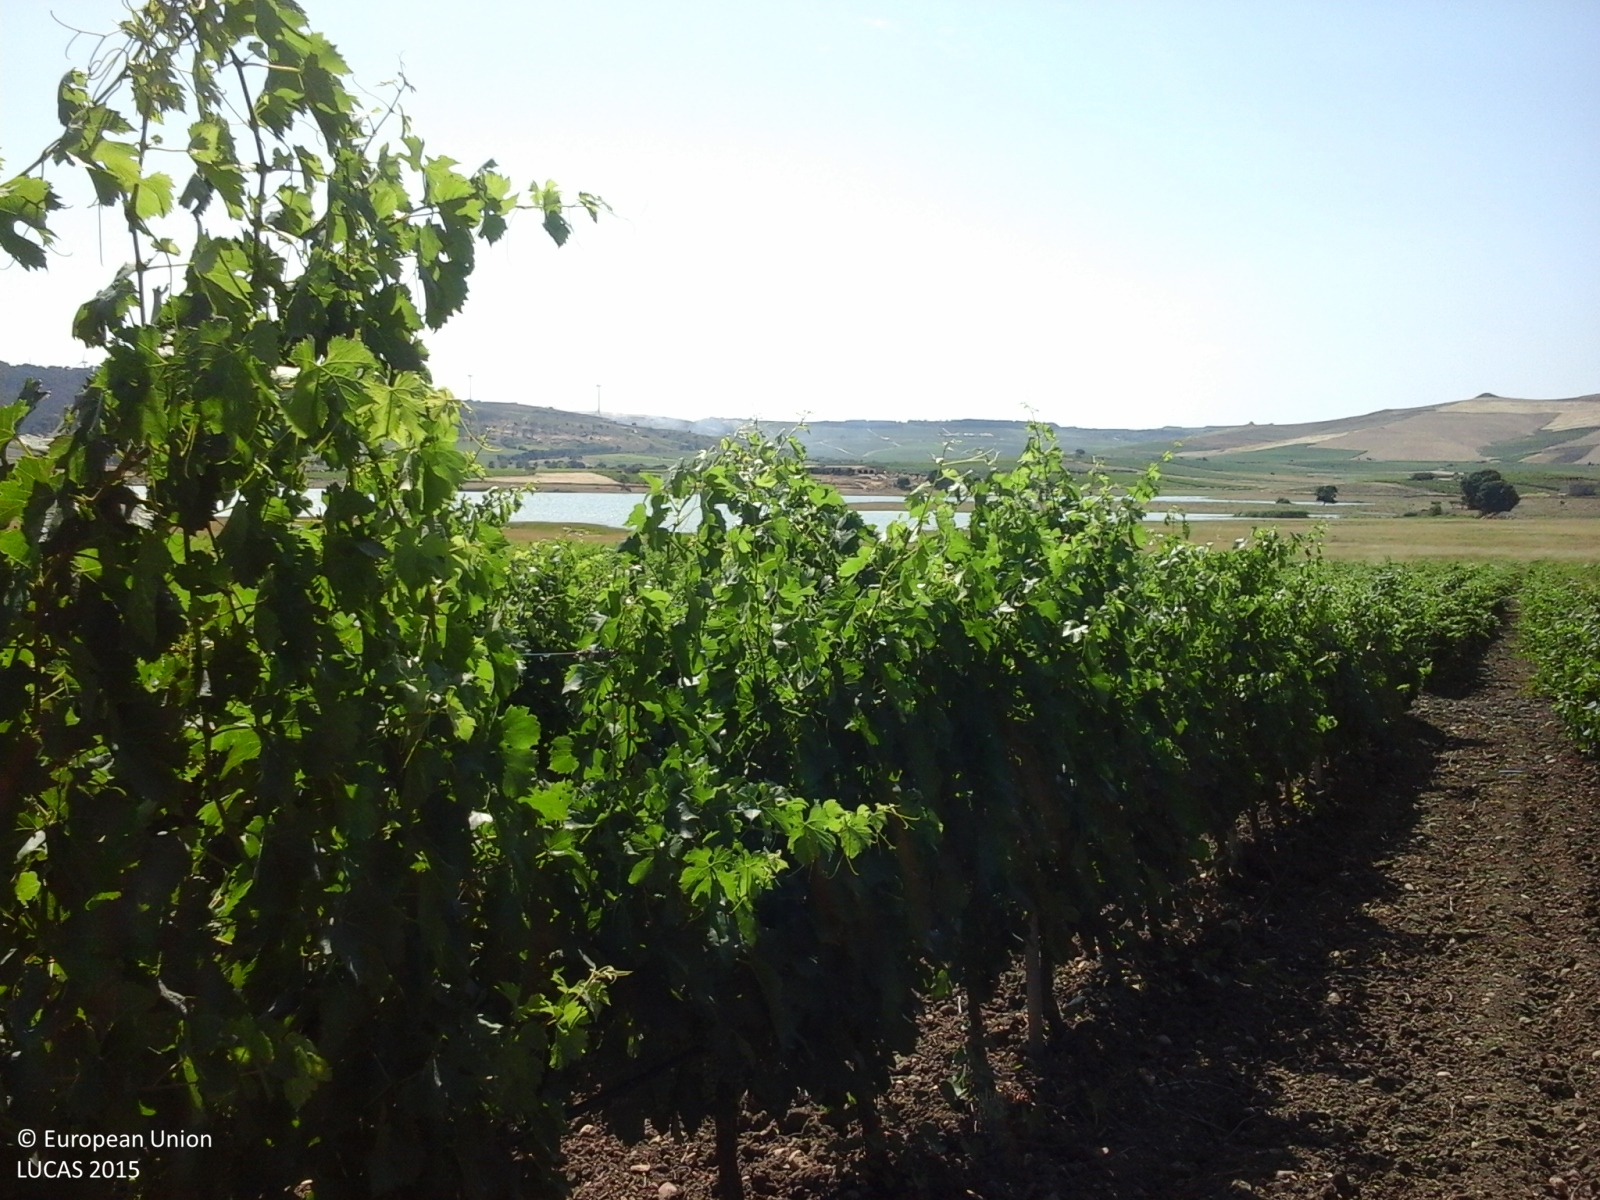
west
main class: Cropland
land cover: Vineyards
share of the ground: 50 - 75 %
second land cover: Other bare soil
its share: > 75 %
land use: Agriculture (excluding fallow land and kitchen gardens)
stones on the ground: < 10 %
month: June
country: IT
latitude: 37.6435
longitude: 13.0708
